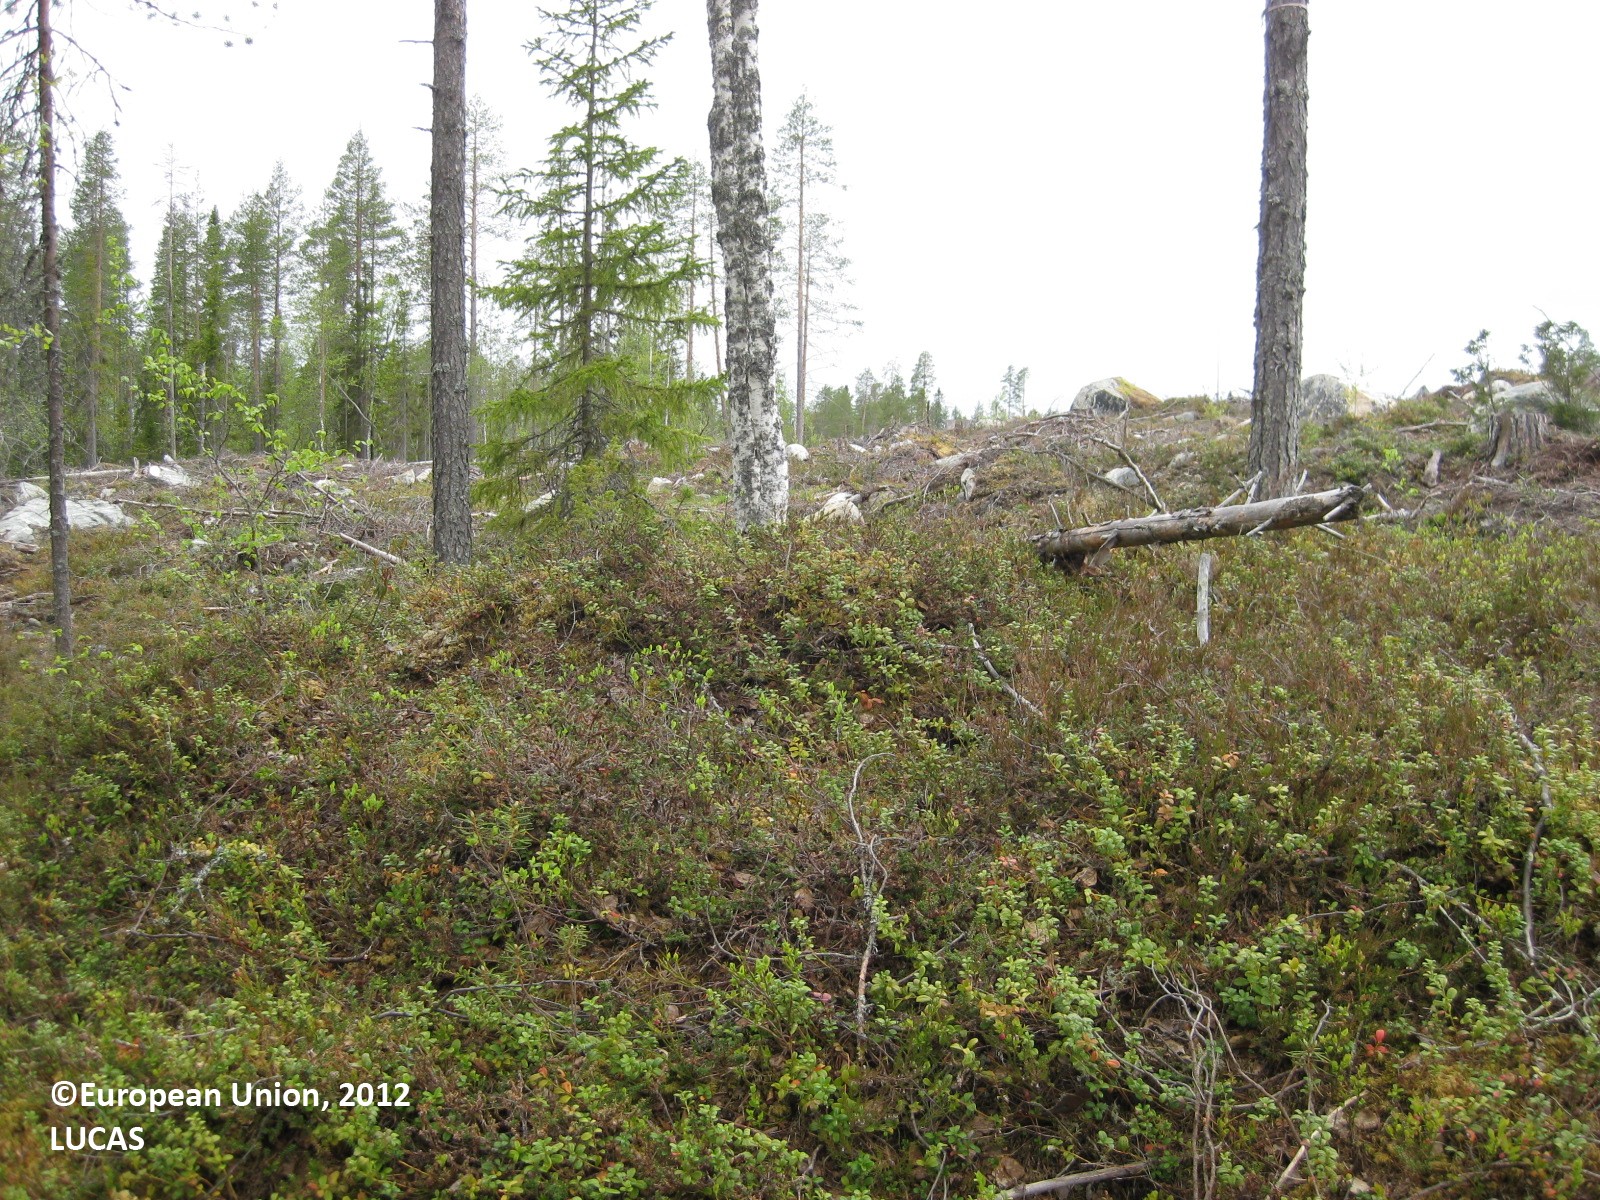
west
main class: Woodland
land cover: Pine dominated mixed woodland
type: boreal forest
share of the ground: 50 - 75 %
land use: Forestry
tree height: > 5 m
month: June
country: FI
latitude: 65.2120
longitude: 29.1944
